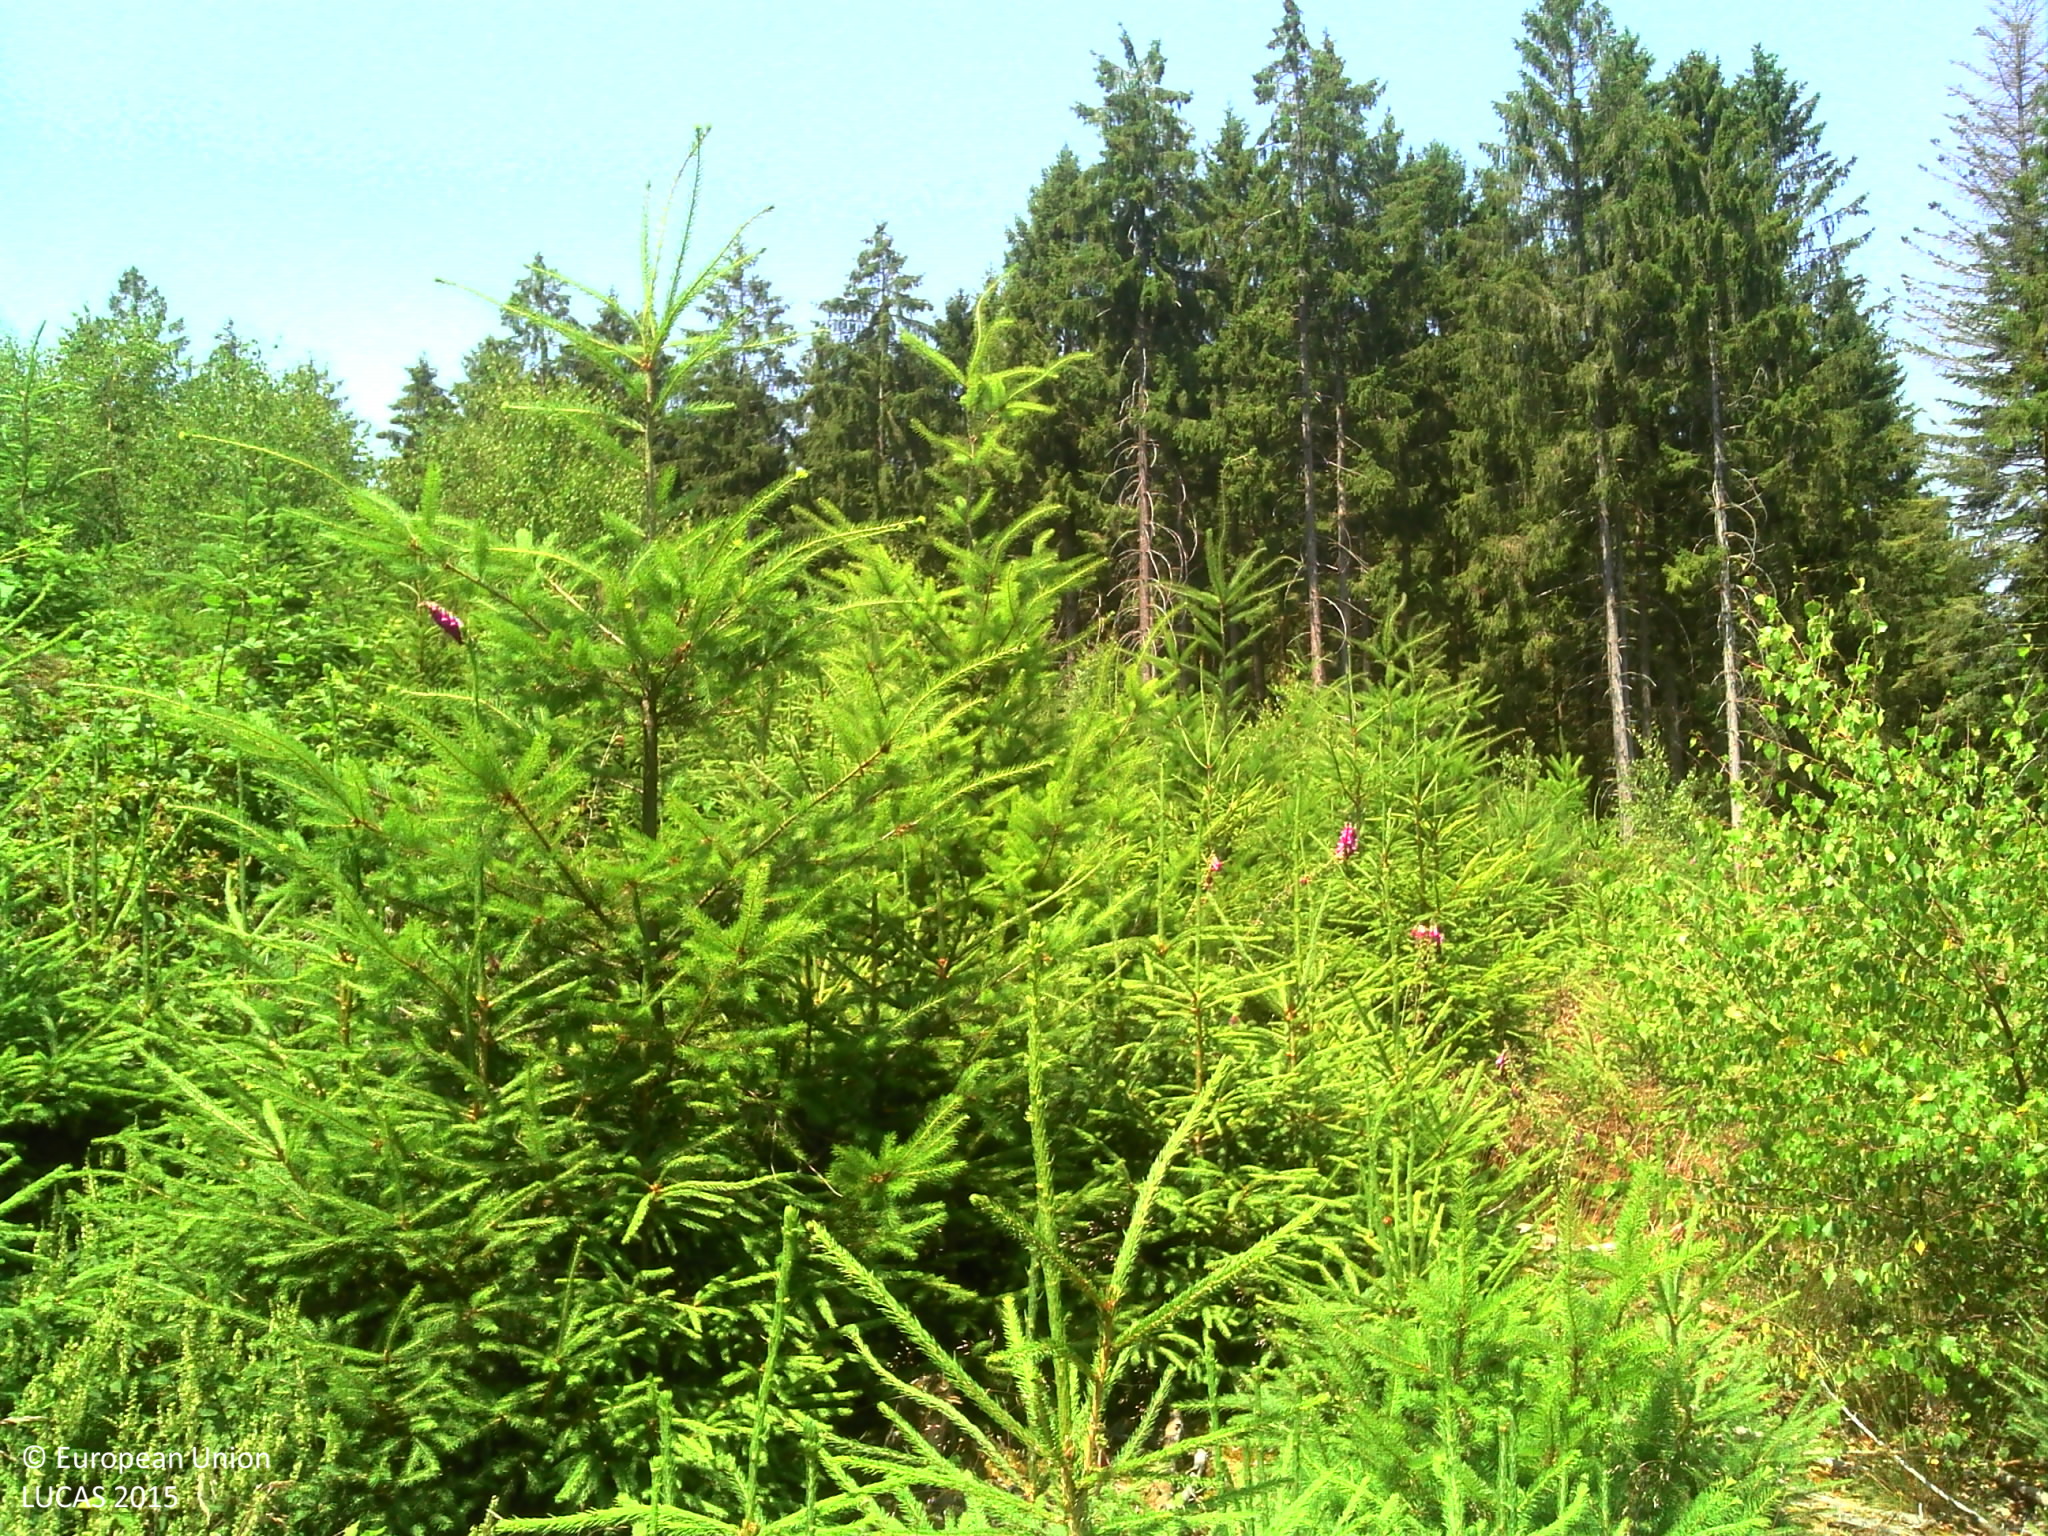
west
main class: Woodland
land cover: Spruce dominated coniferous woodland
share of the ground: > 75 %
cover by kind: coniferous forest trees 100 %
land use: Forestry
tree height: < 5 m
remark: Clear cut
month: July
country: FR
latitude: 47.1397
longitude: 3.9993
